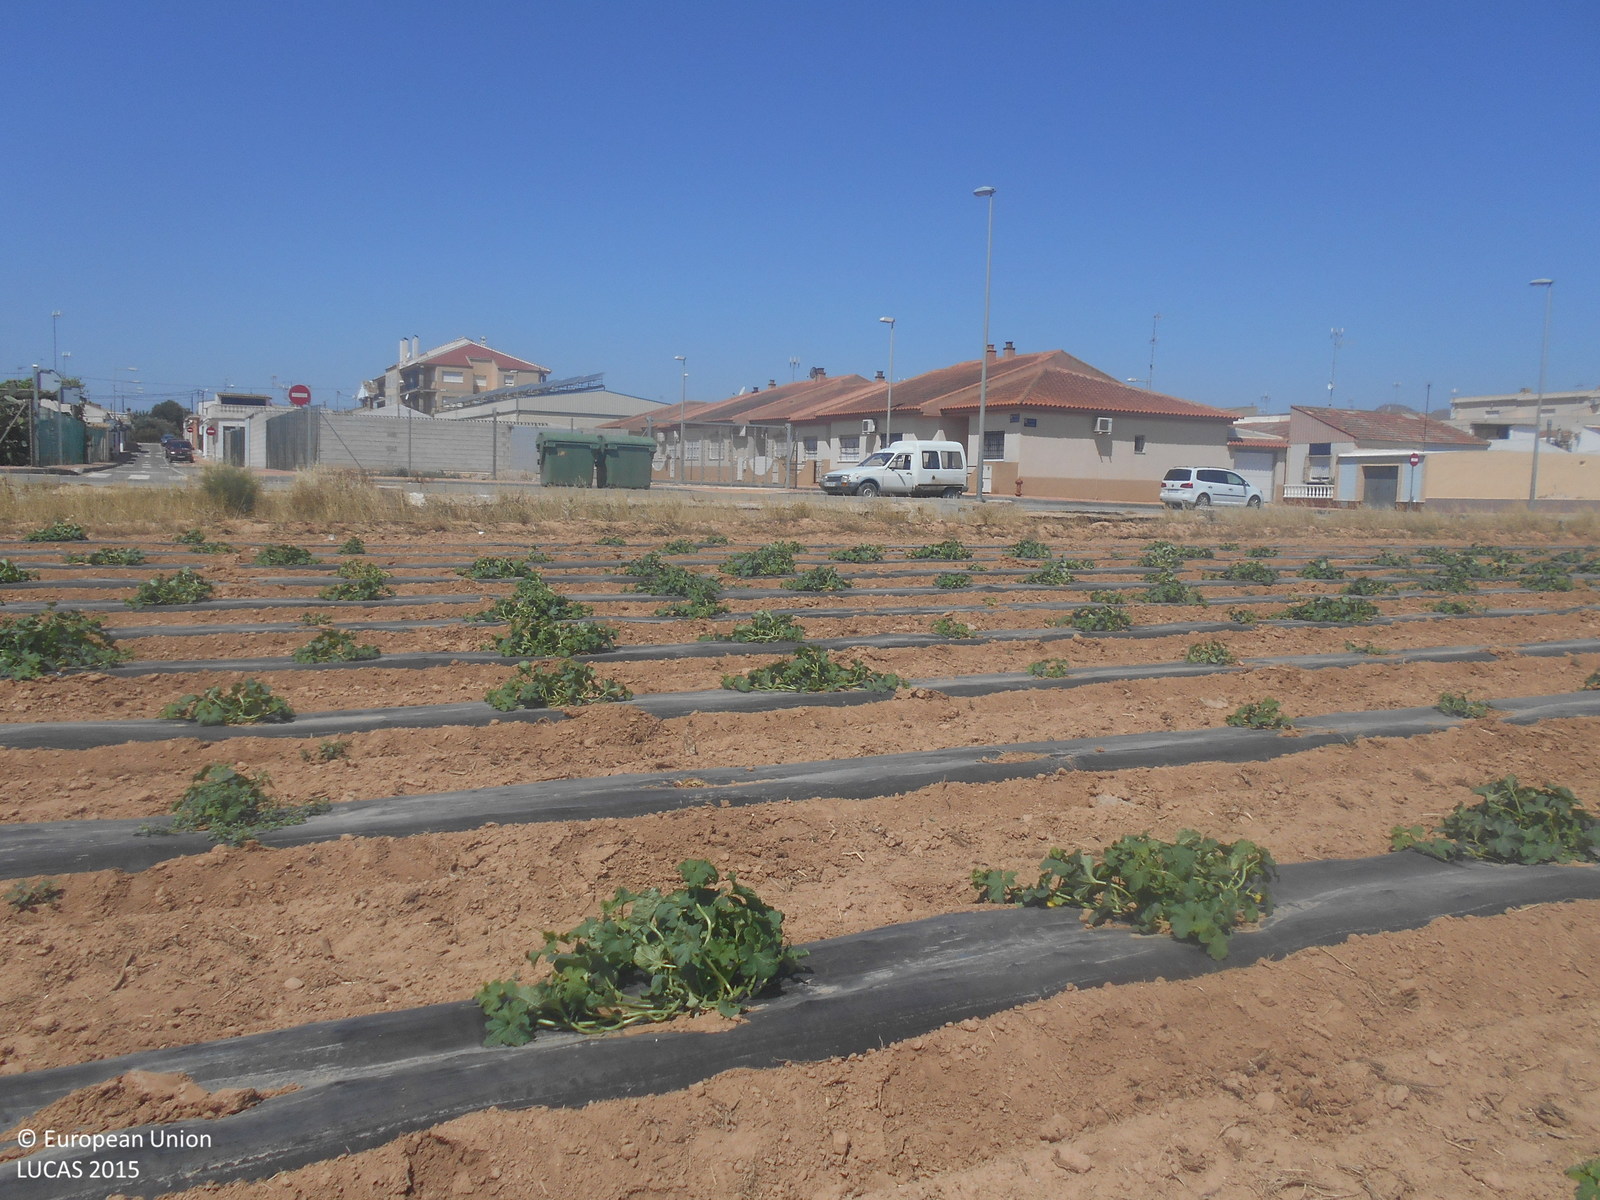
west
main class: Cropland
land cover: Other fresh vegetables
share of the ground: 10 - 25 %
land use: Agriculture (excluding fallow land and kitchen gardens)
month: May
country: ES
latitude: 37.7808
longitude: -0.8689
